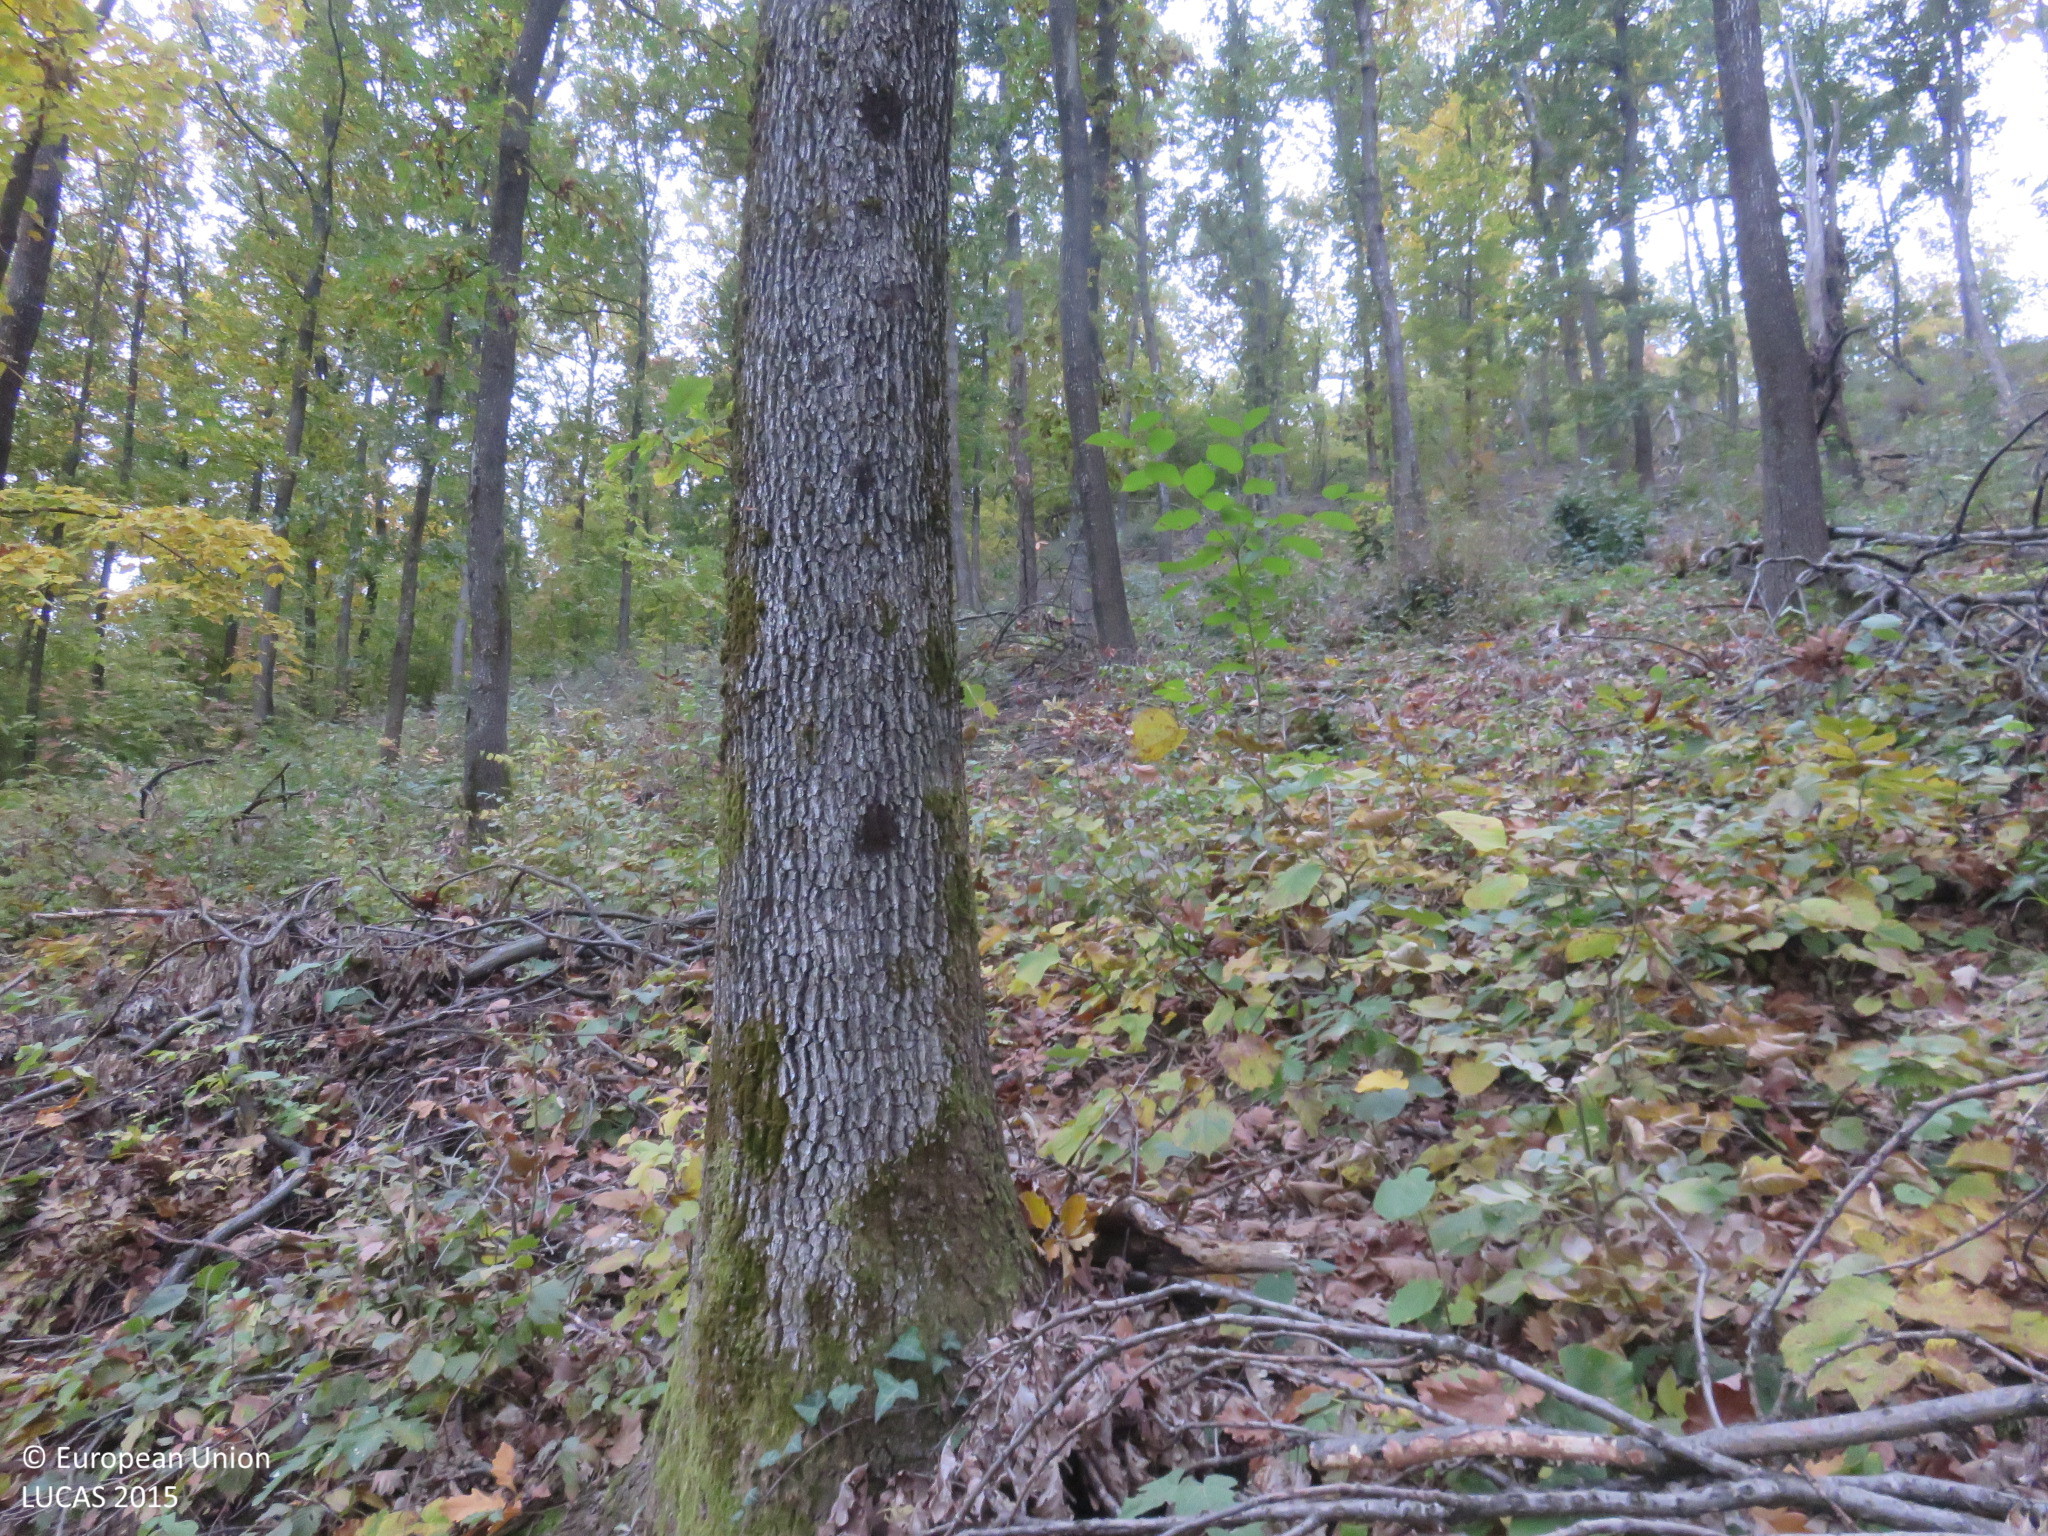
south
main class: Woodland
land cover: Broadleaved woodland
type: mesophytic deciduous forest
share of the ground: > 75 %
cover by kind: broadleaved forest trees 80 %, shrubs 10 %, herbaceous plants 10 %
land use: Forestry
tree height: > 5 m
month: October
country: BG
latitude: 42.9443
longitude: 24.9800
